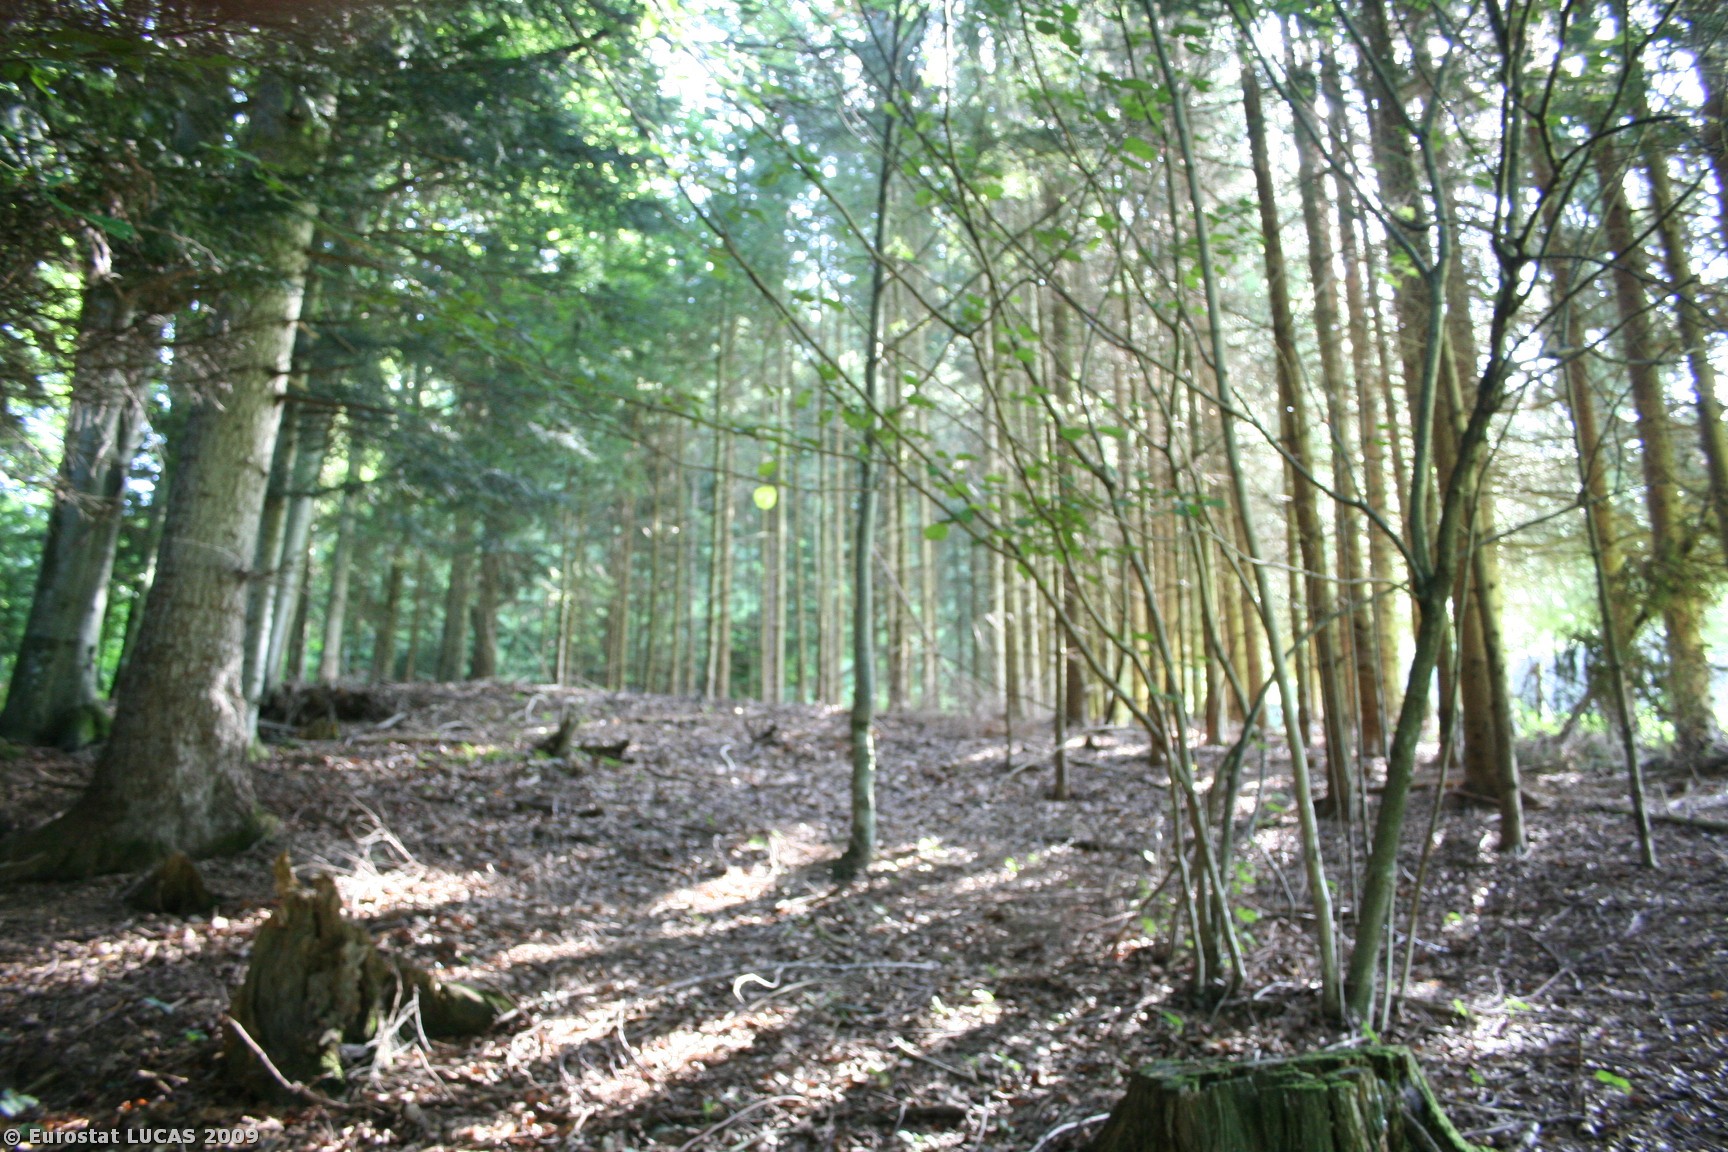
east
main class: Woodland
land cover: Mixed woodland
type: hemiboreal forest and nemoral coniferous forest and mixed broadleaved-coniferous forest
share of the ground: > 75 %
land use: Forestry
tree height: > 5 m
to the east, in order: Mixed woodland; Coniferous woodland; Fences; Coniferous woodland; Tracks; Fences; Coniferous woodland; Shrubland without tree cover; Mixed woodland; Tracks; Shrubland with sparse tree cover; Mixed woodland
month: August
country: AT
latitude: 47.7085
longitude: 13.2106
